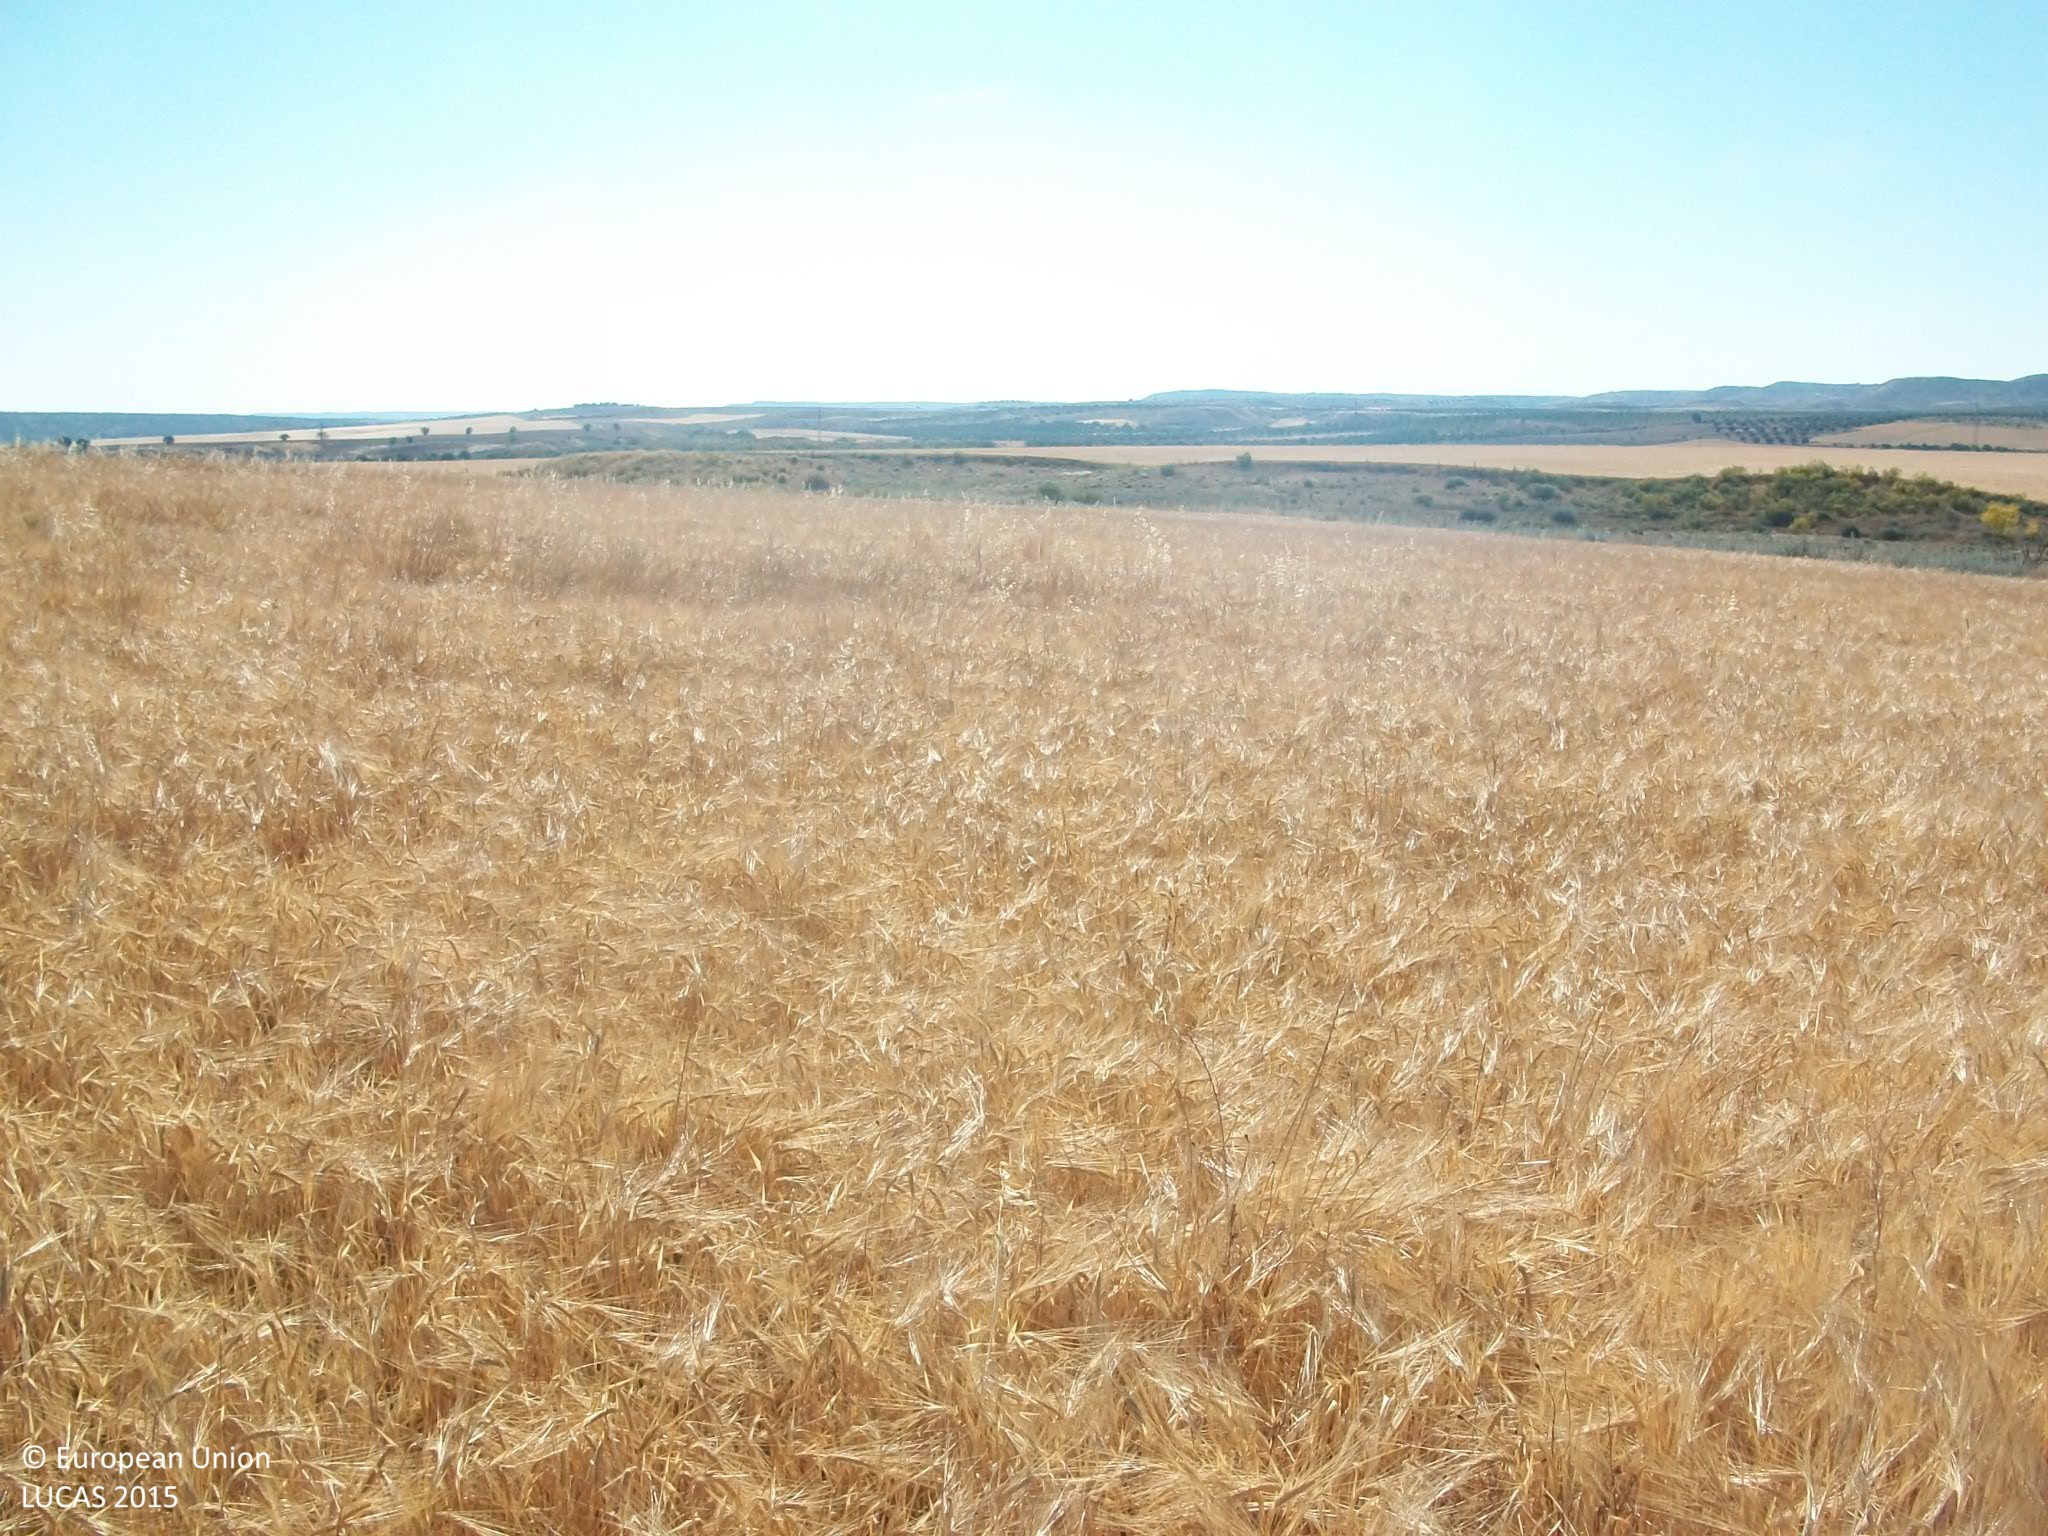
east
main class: Cropland
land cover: Barley
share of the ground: > 75 %
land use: Agriculture (excluding fallow land and kitchen gardens)
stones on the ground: > 50 %
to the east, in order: Barley; Grass margins; Barley; Fences; Grass margins; Tracks; Grassland without tree/shrub cover; Paved roads, cycling and walking lanes; Grassland without tree/shrub cover
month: May
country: ES
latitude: 39.9618
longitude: -3.6932
